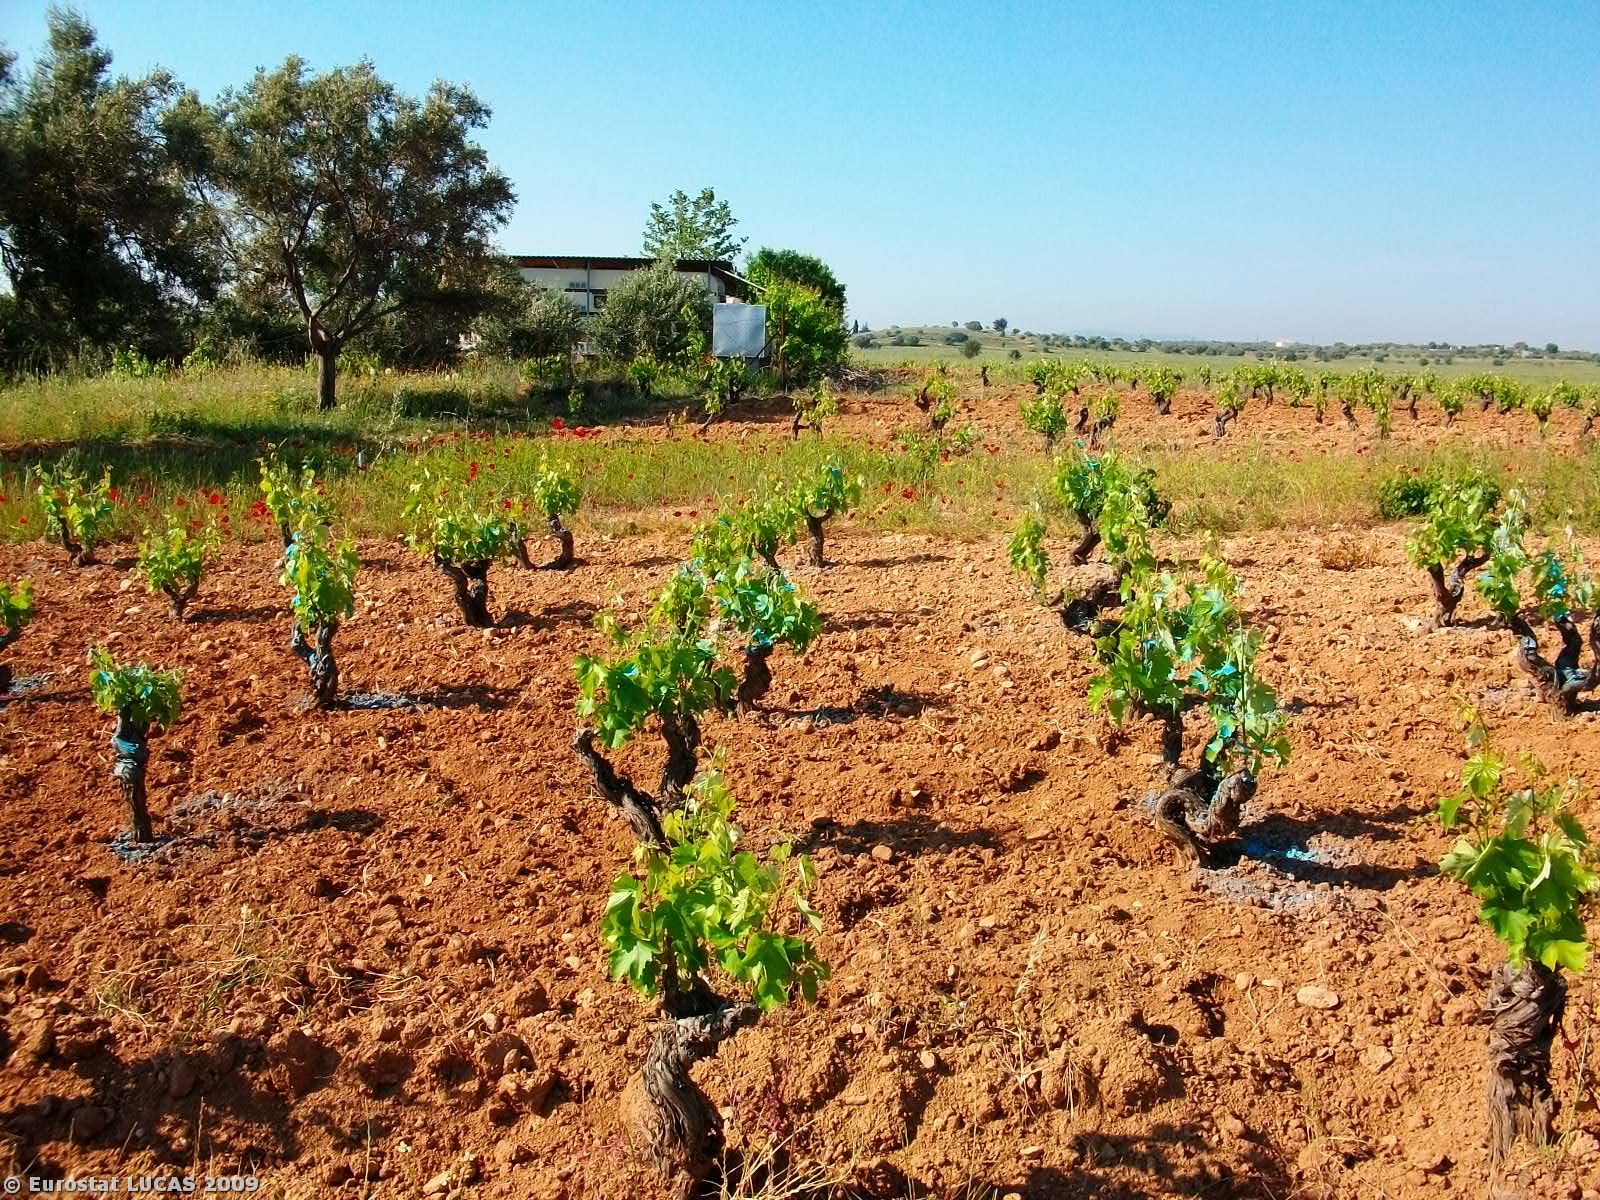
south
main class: Cropland
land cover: Vineyards
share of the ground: 25 - 50 %
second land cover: Bare land
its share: > 75 %
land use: Agriculture (excluding fallow land and kitchen gardens)
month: May
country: GR
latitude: 37.9808
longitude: 23.9523
